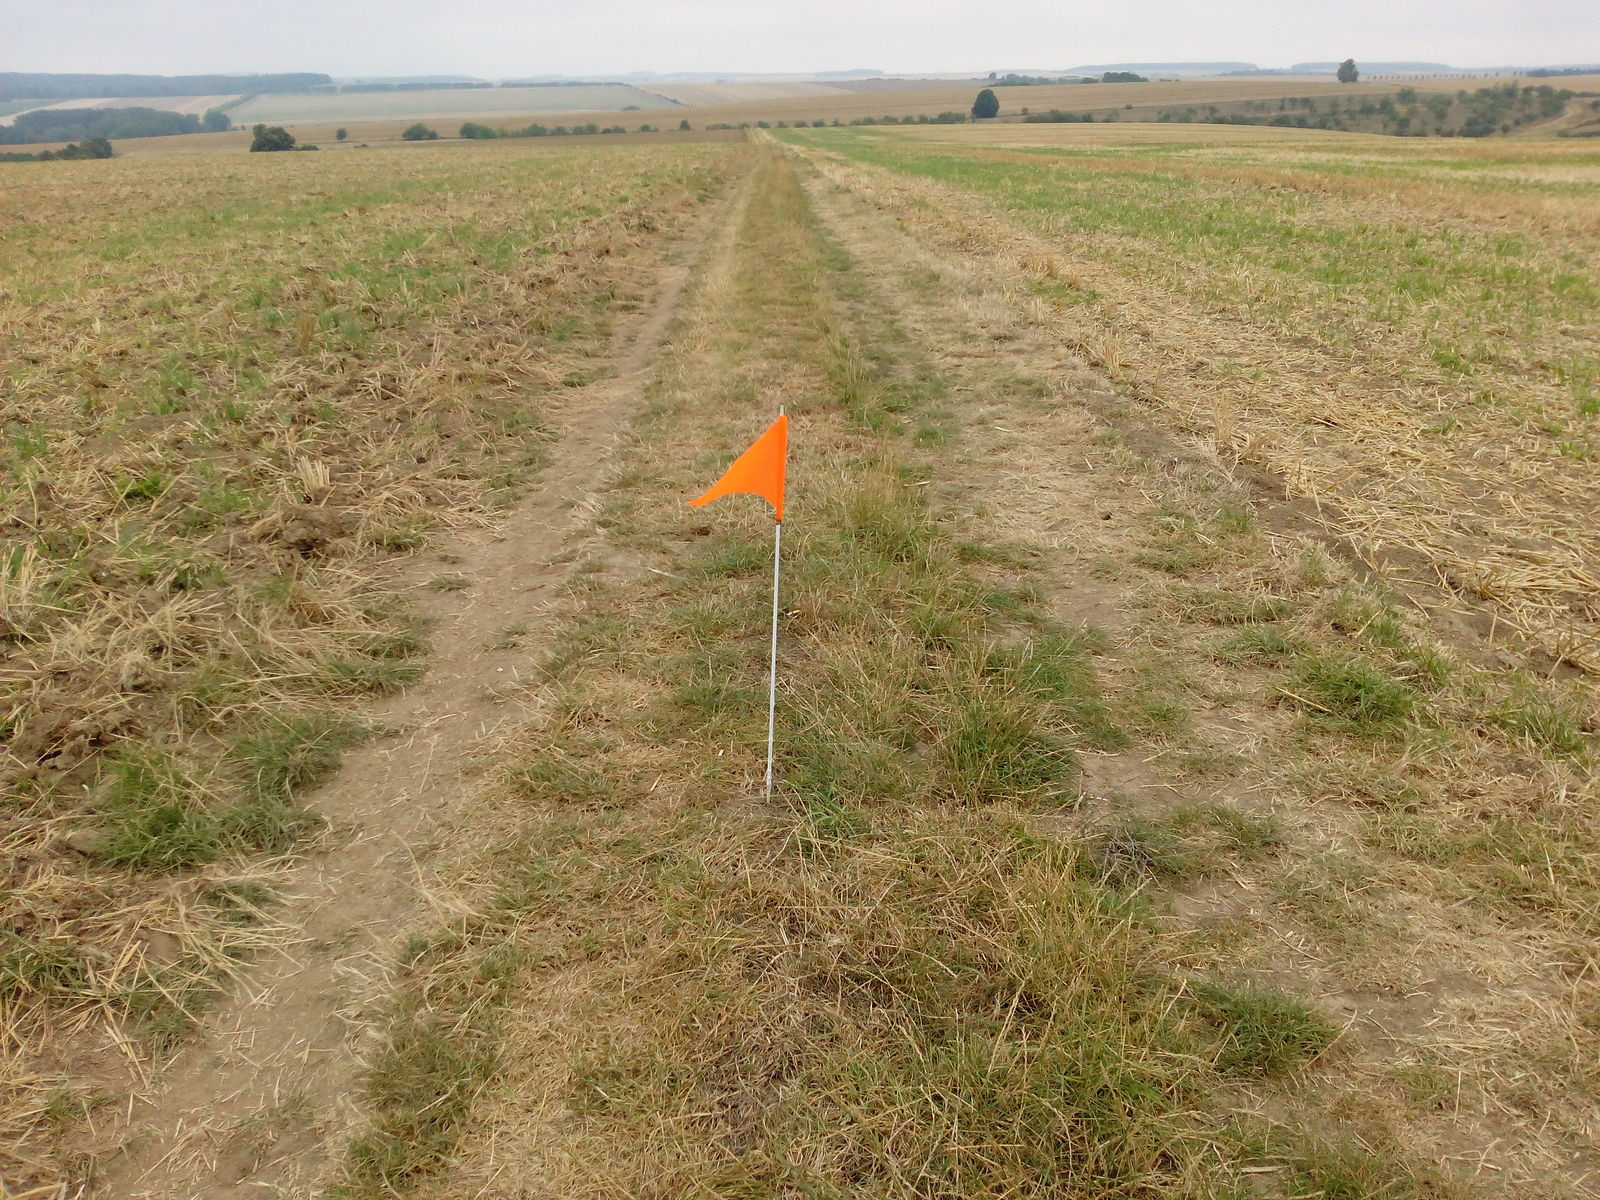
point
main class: Cropland
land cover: Barley
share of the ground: 10 - 25 %
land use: Agriculture (excluding fallow land and kitchen gardens)
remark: Harvested field
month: August
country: DE
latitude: 51.2254
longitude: 10.6156
